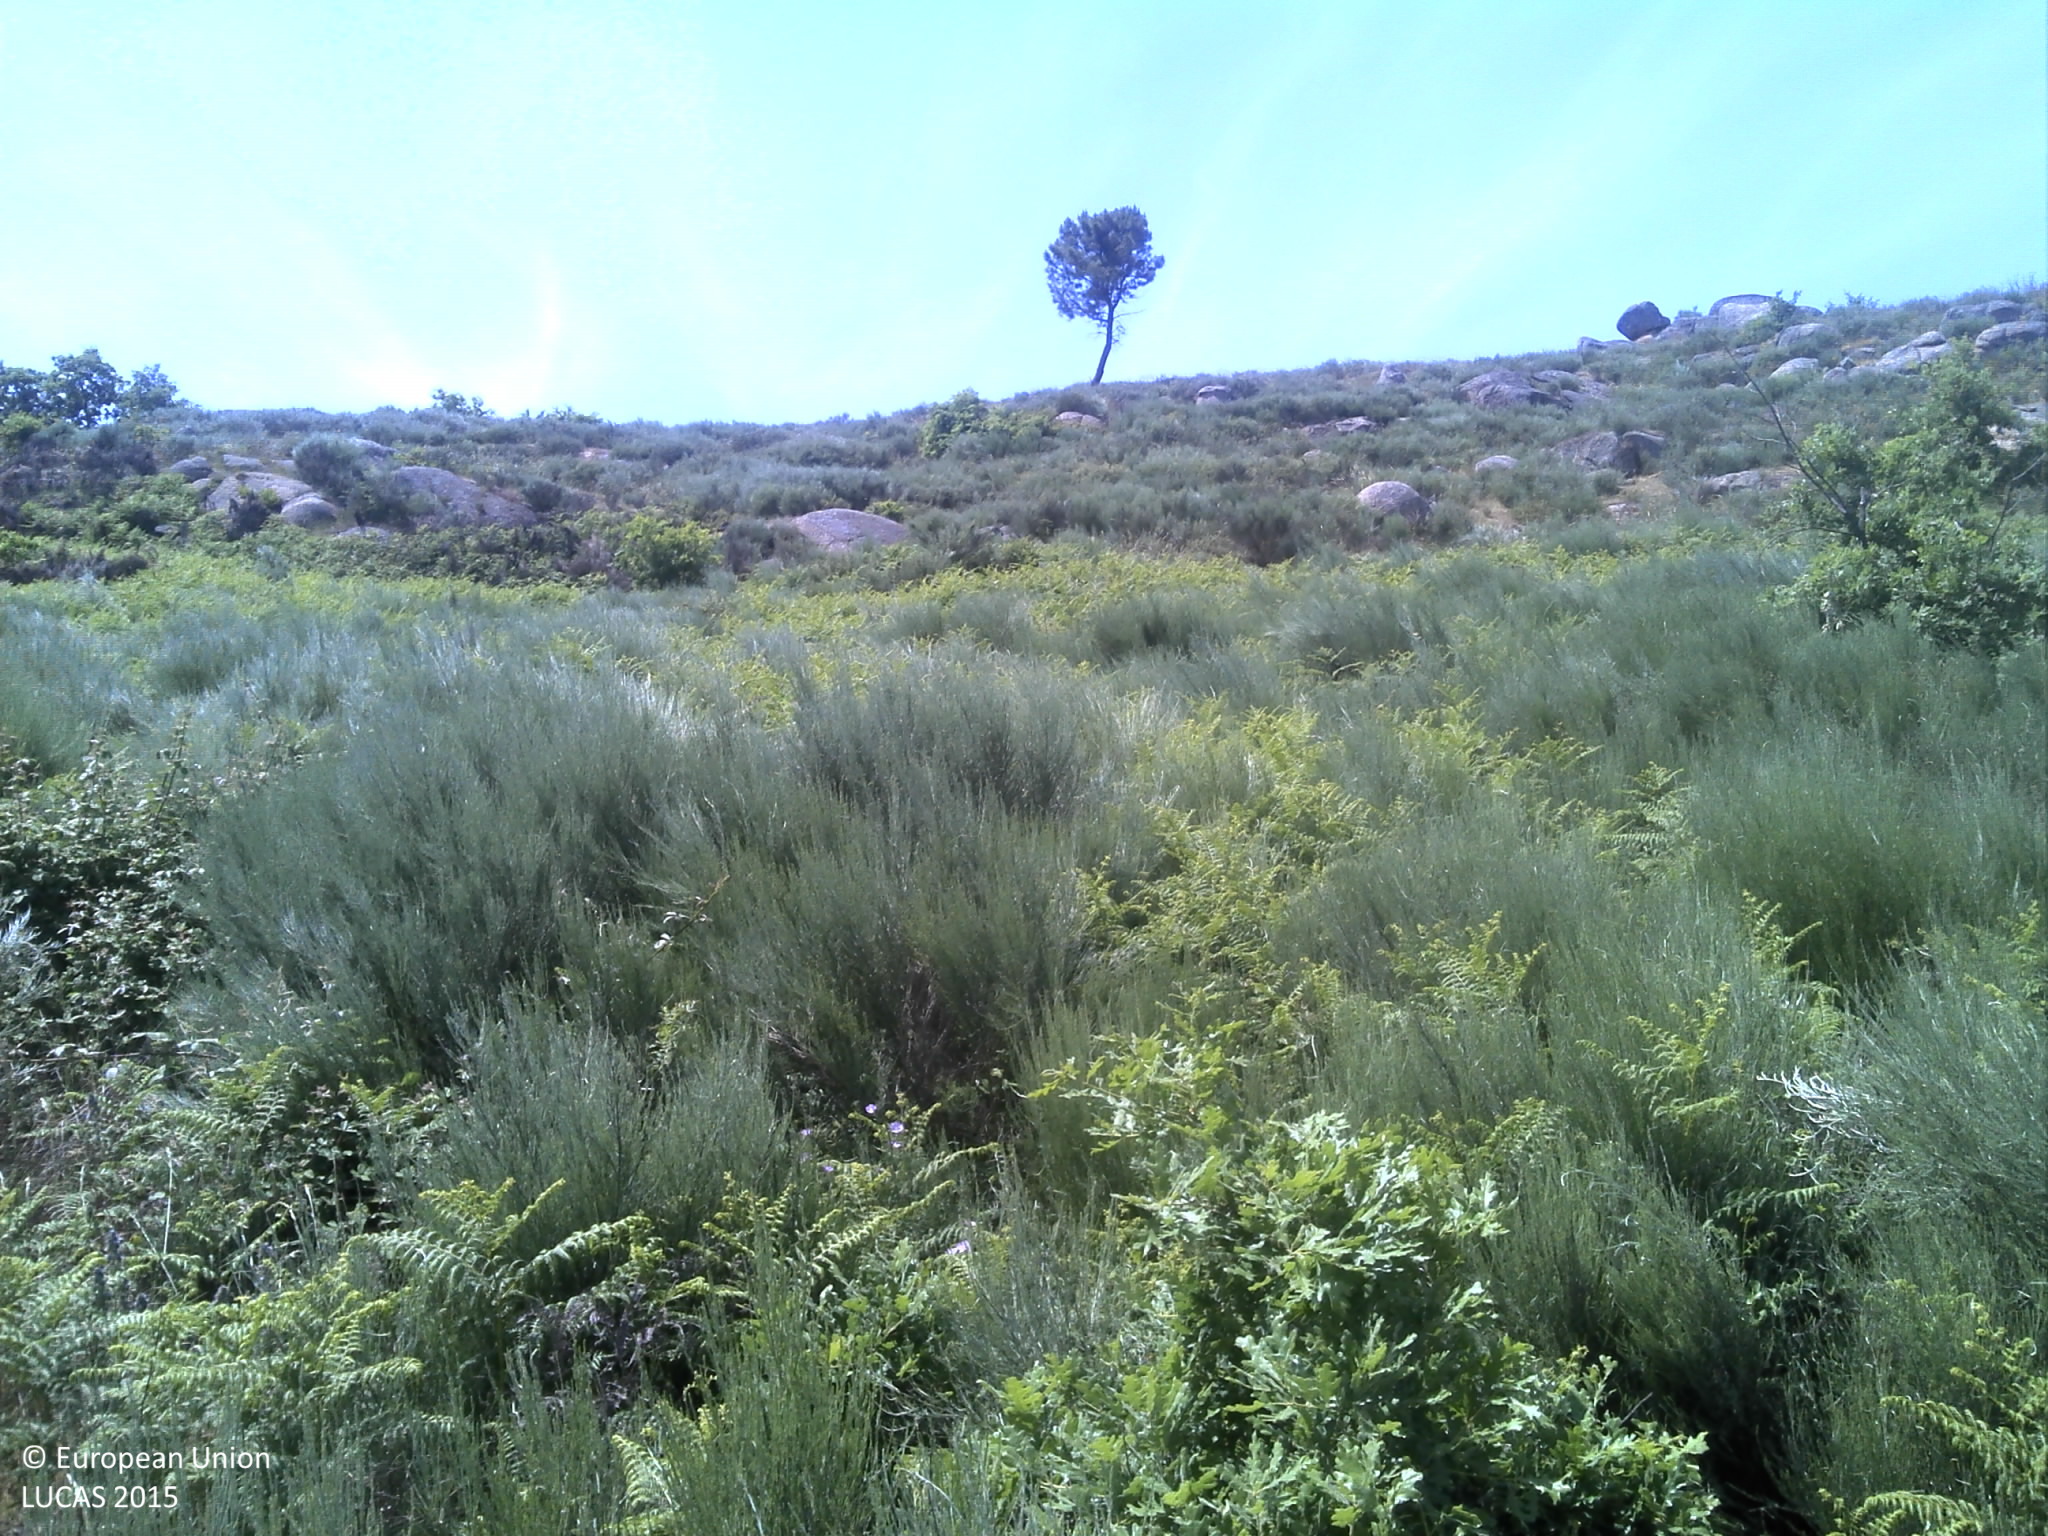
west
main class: Shrubland
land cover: Shrubland without tree cover
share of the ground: 50 - 75 %
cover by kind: shrubs 75 %, herbaceous plants 20 %, unconsolidated bare surface 5 %
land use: Semi-natural and natural areas not in use
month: May
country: PT
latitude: 40.6090
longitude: -7.4499
